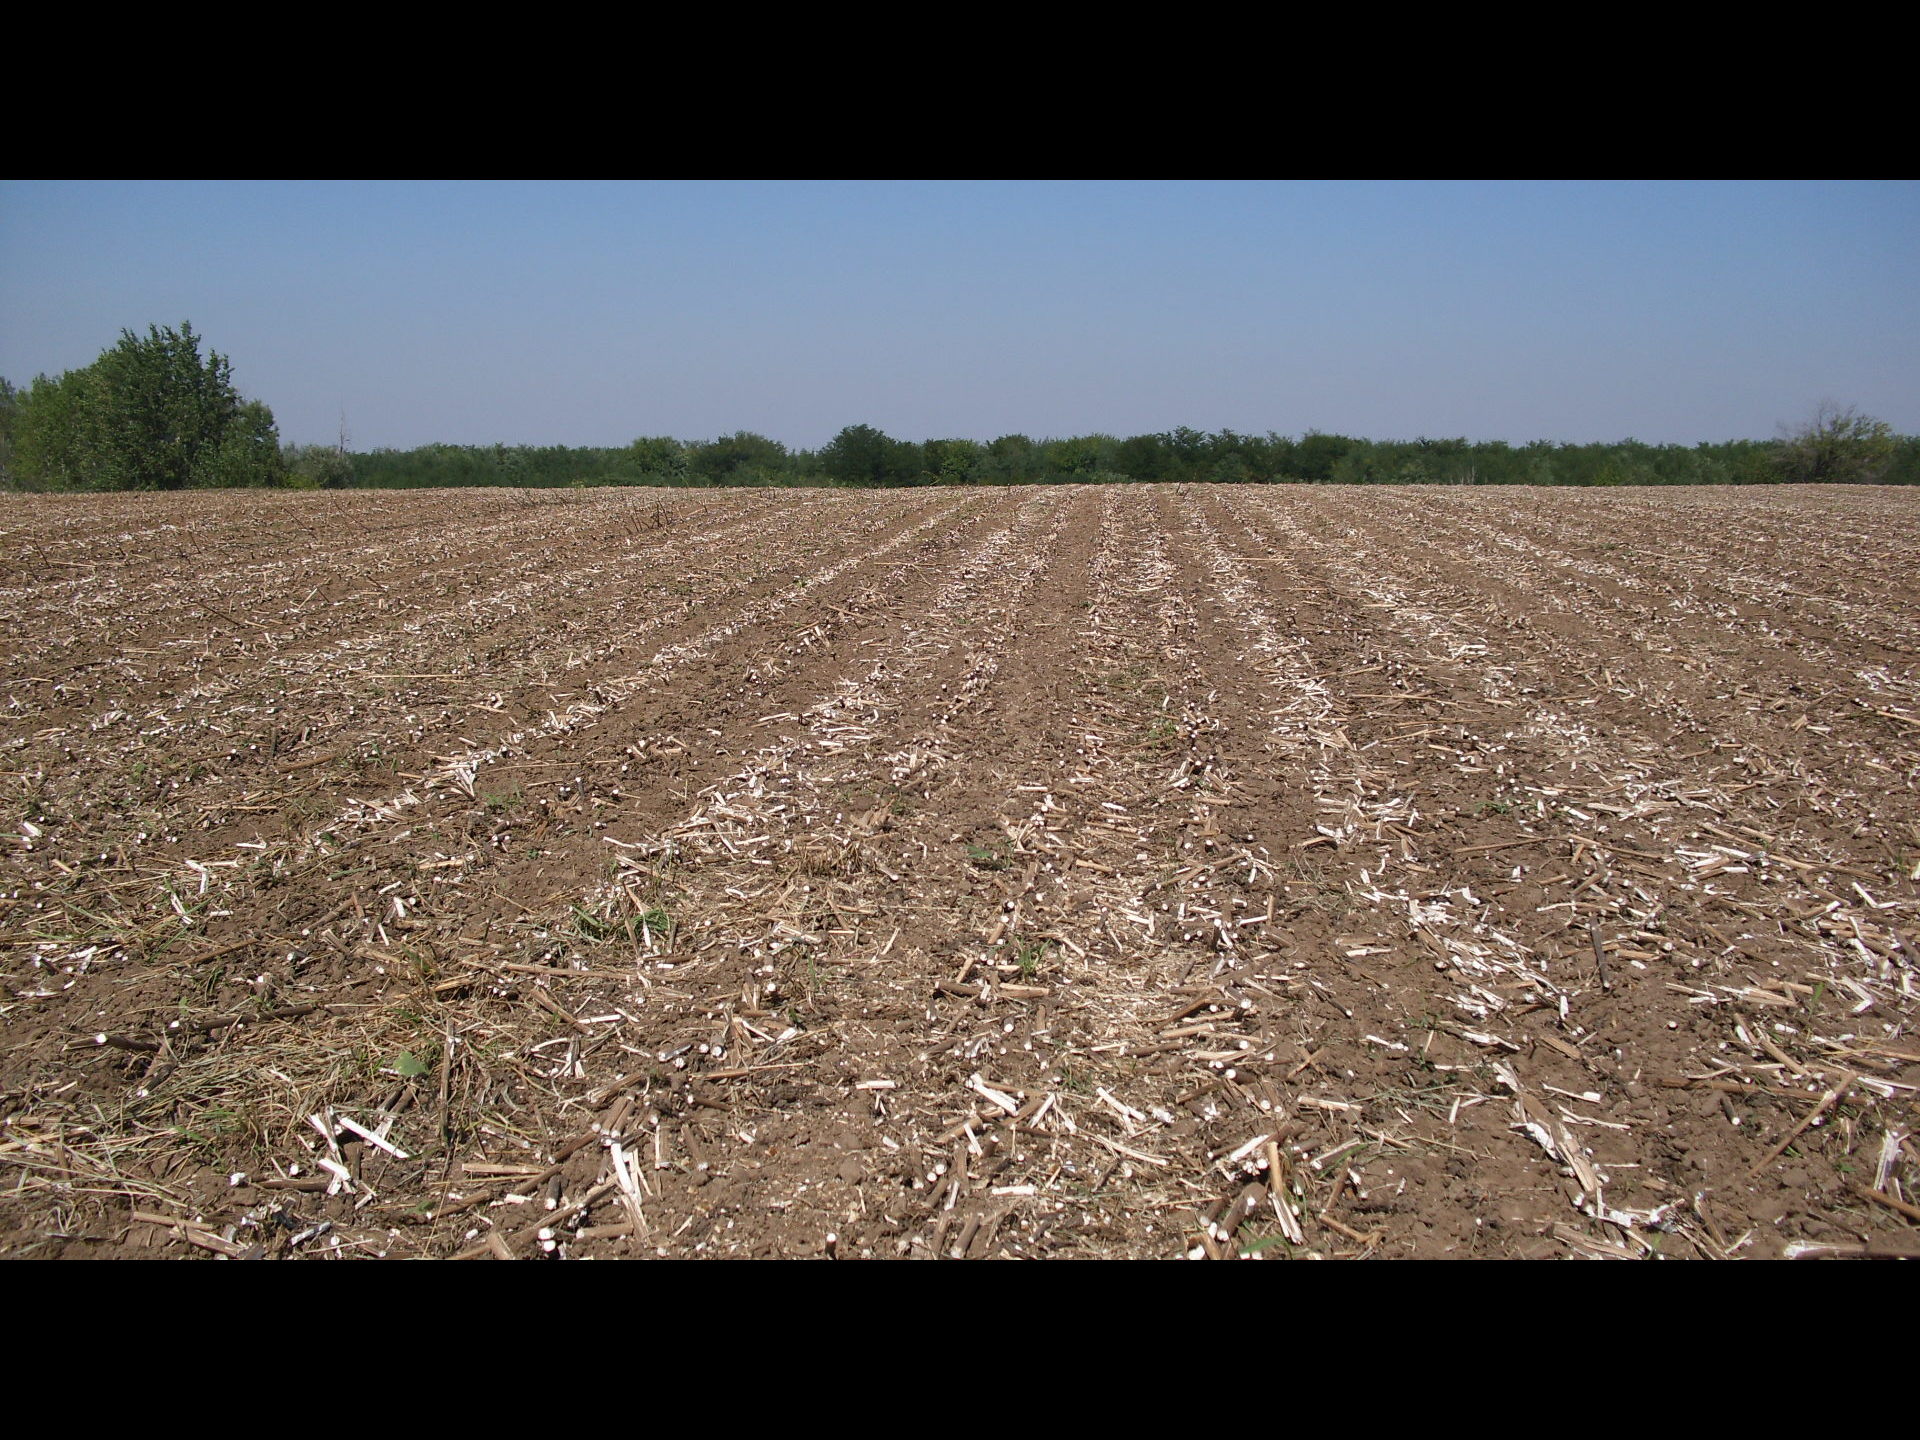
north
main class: Cropland
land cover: Sunflower
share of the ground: < 10 %
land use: Agriculture (excluding fallow land and kitchen gardens)
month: August
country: BG
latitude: 44.1230
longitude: 22.7734
